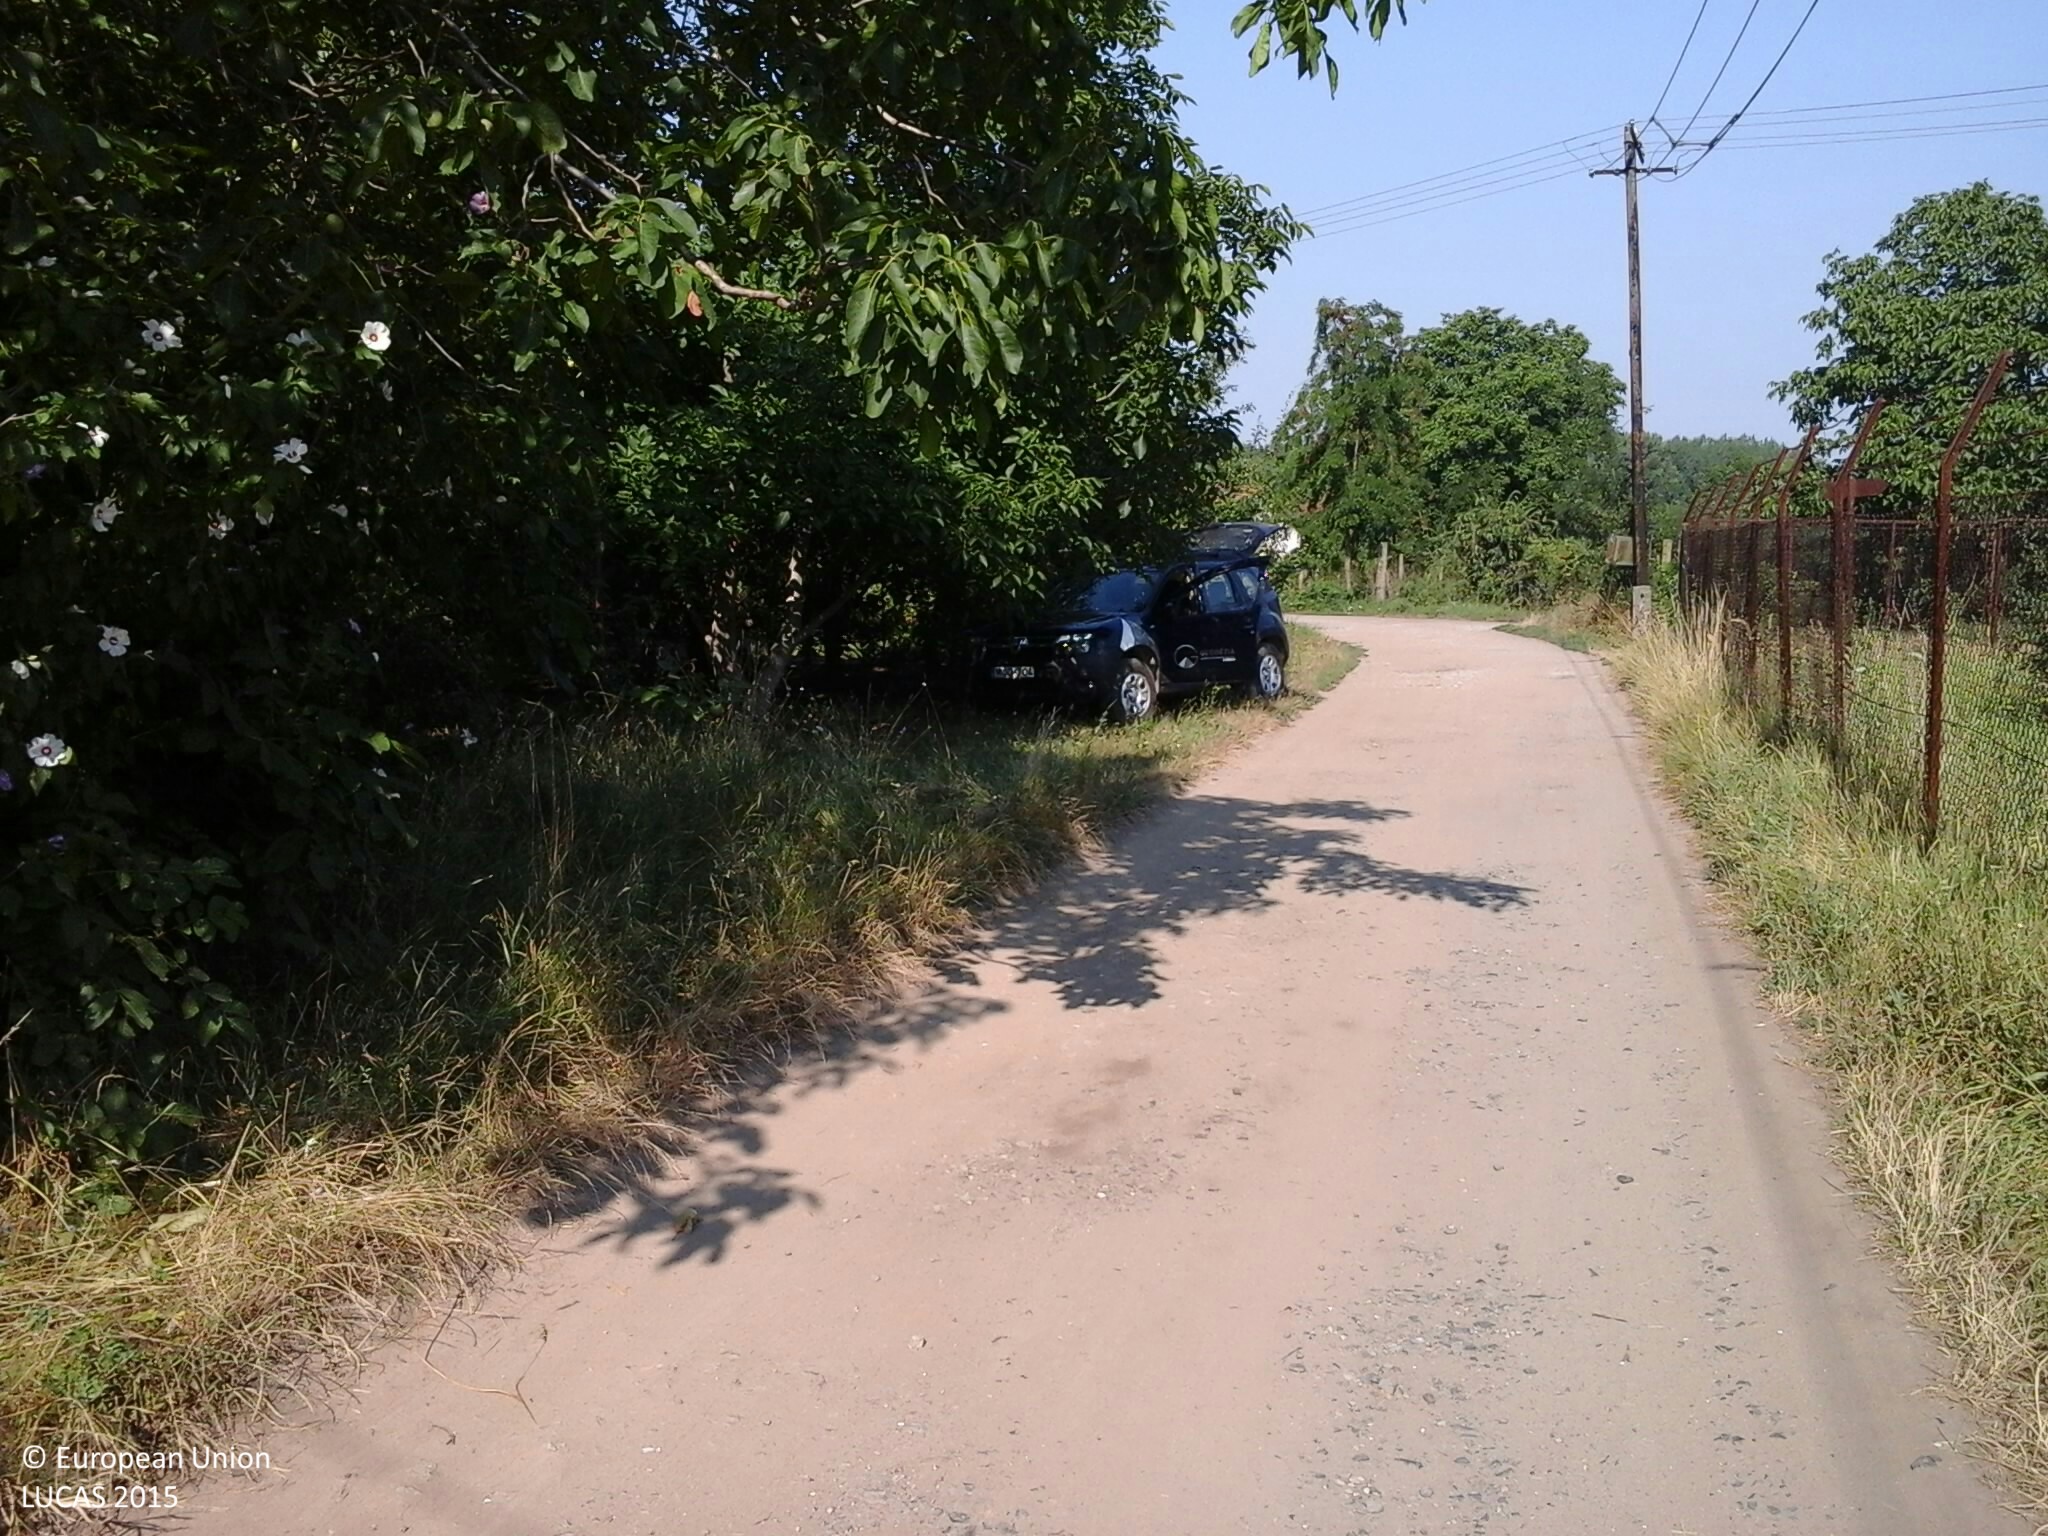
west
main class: Grassland
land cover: Grassland without tree/shrub cover
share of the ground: > 75 %
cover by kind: herbaceous plants 100 %
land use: Residential
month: July
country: HU
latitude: 47.5802
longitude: 21.3557
